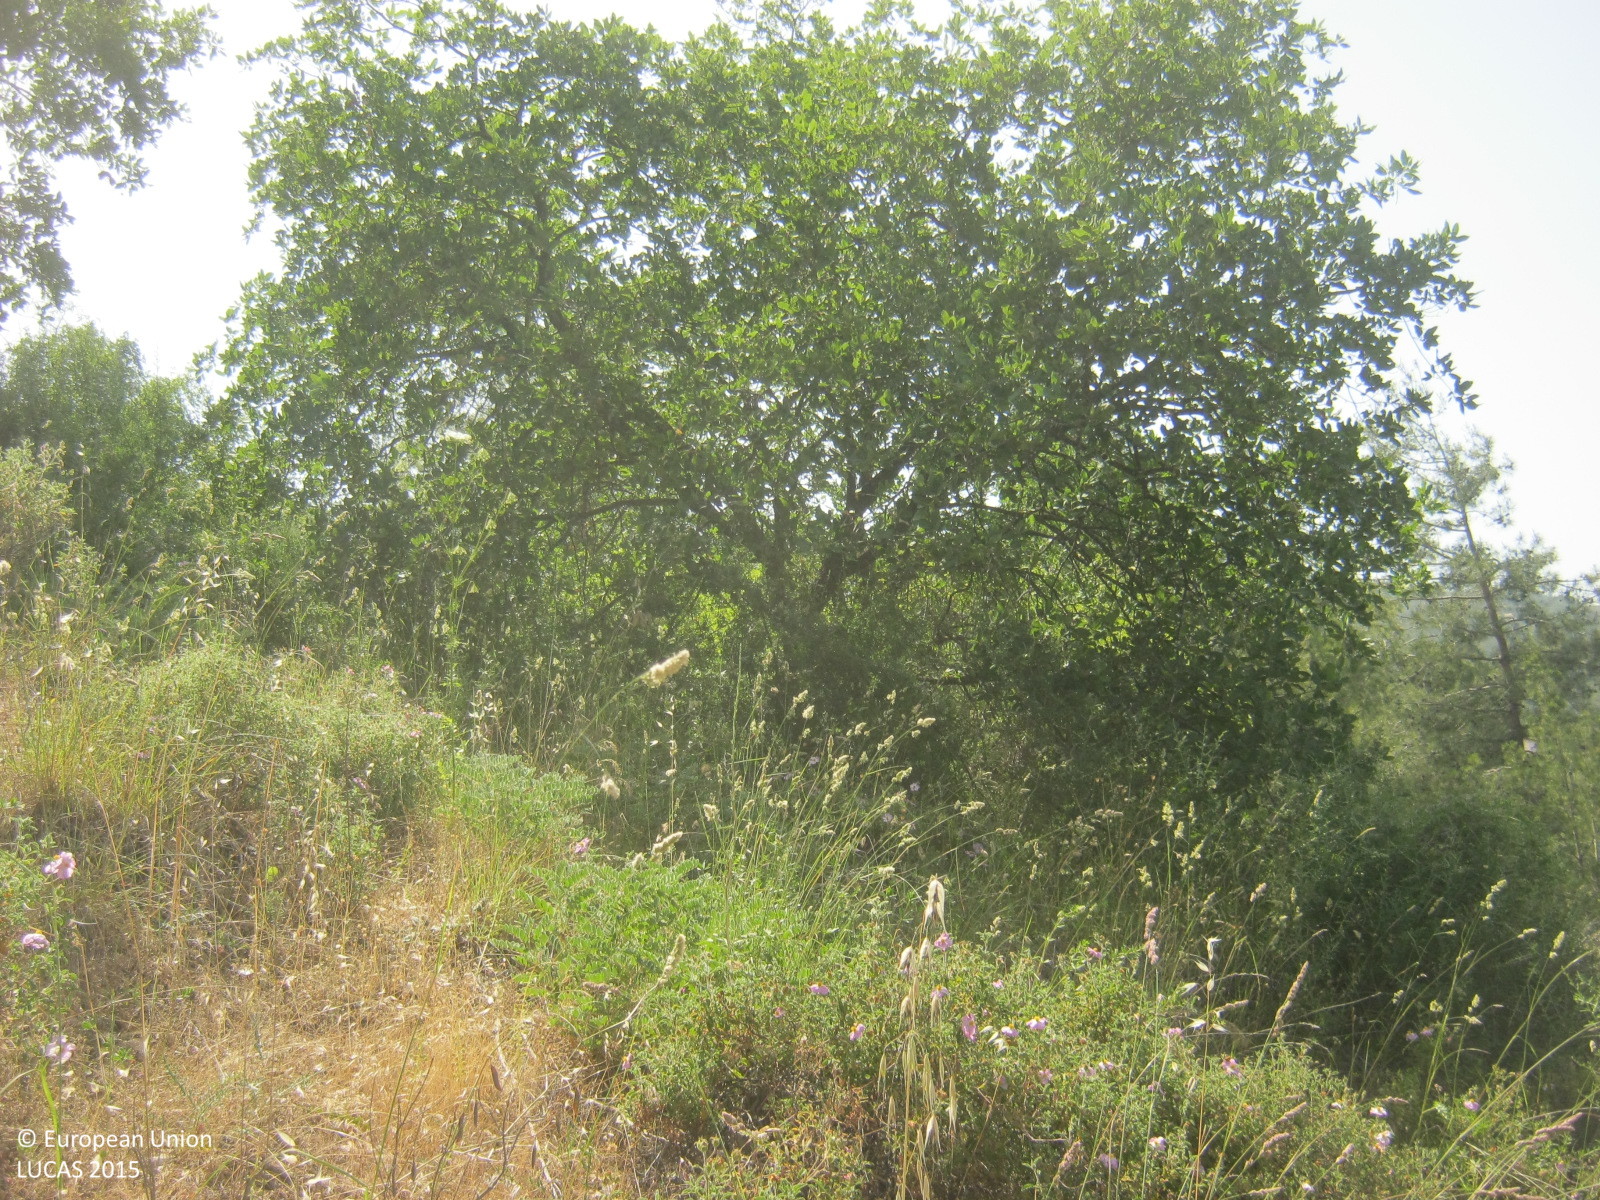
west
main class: Shrubland
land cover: Shrubland with sparse tree cover
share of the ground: > 75 %
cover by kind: shrubs 85 %, coniferous forest trees 5 %, herbaceous plants 5 %, unconsolidated bare surface 5 %
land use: Semi-natural and natural areas not in use
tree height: > 5 m
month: May
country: CY
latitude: 35.0105
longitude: 32.8861
